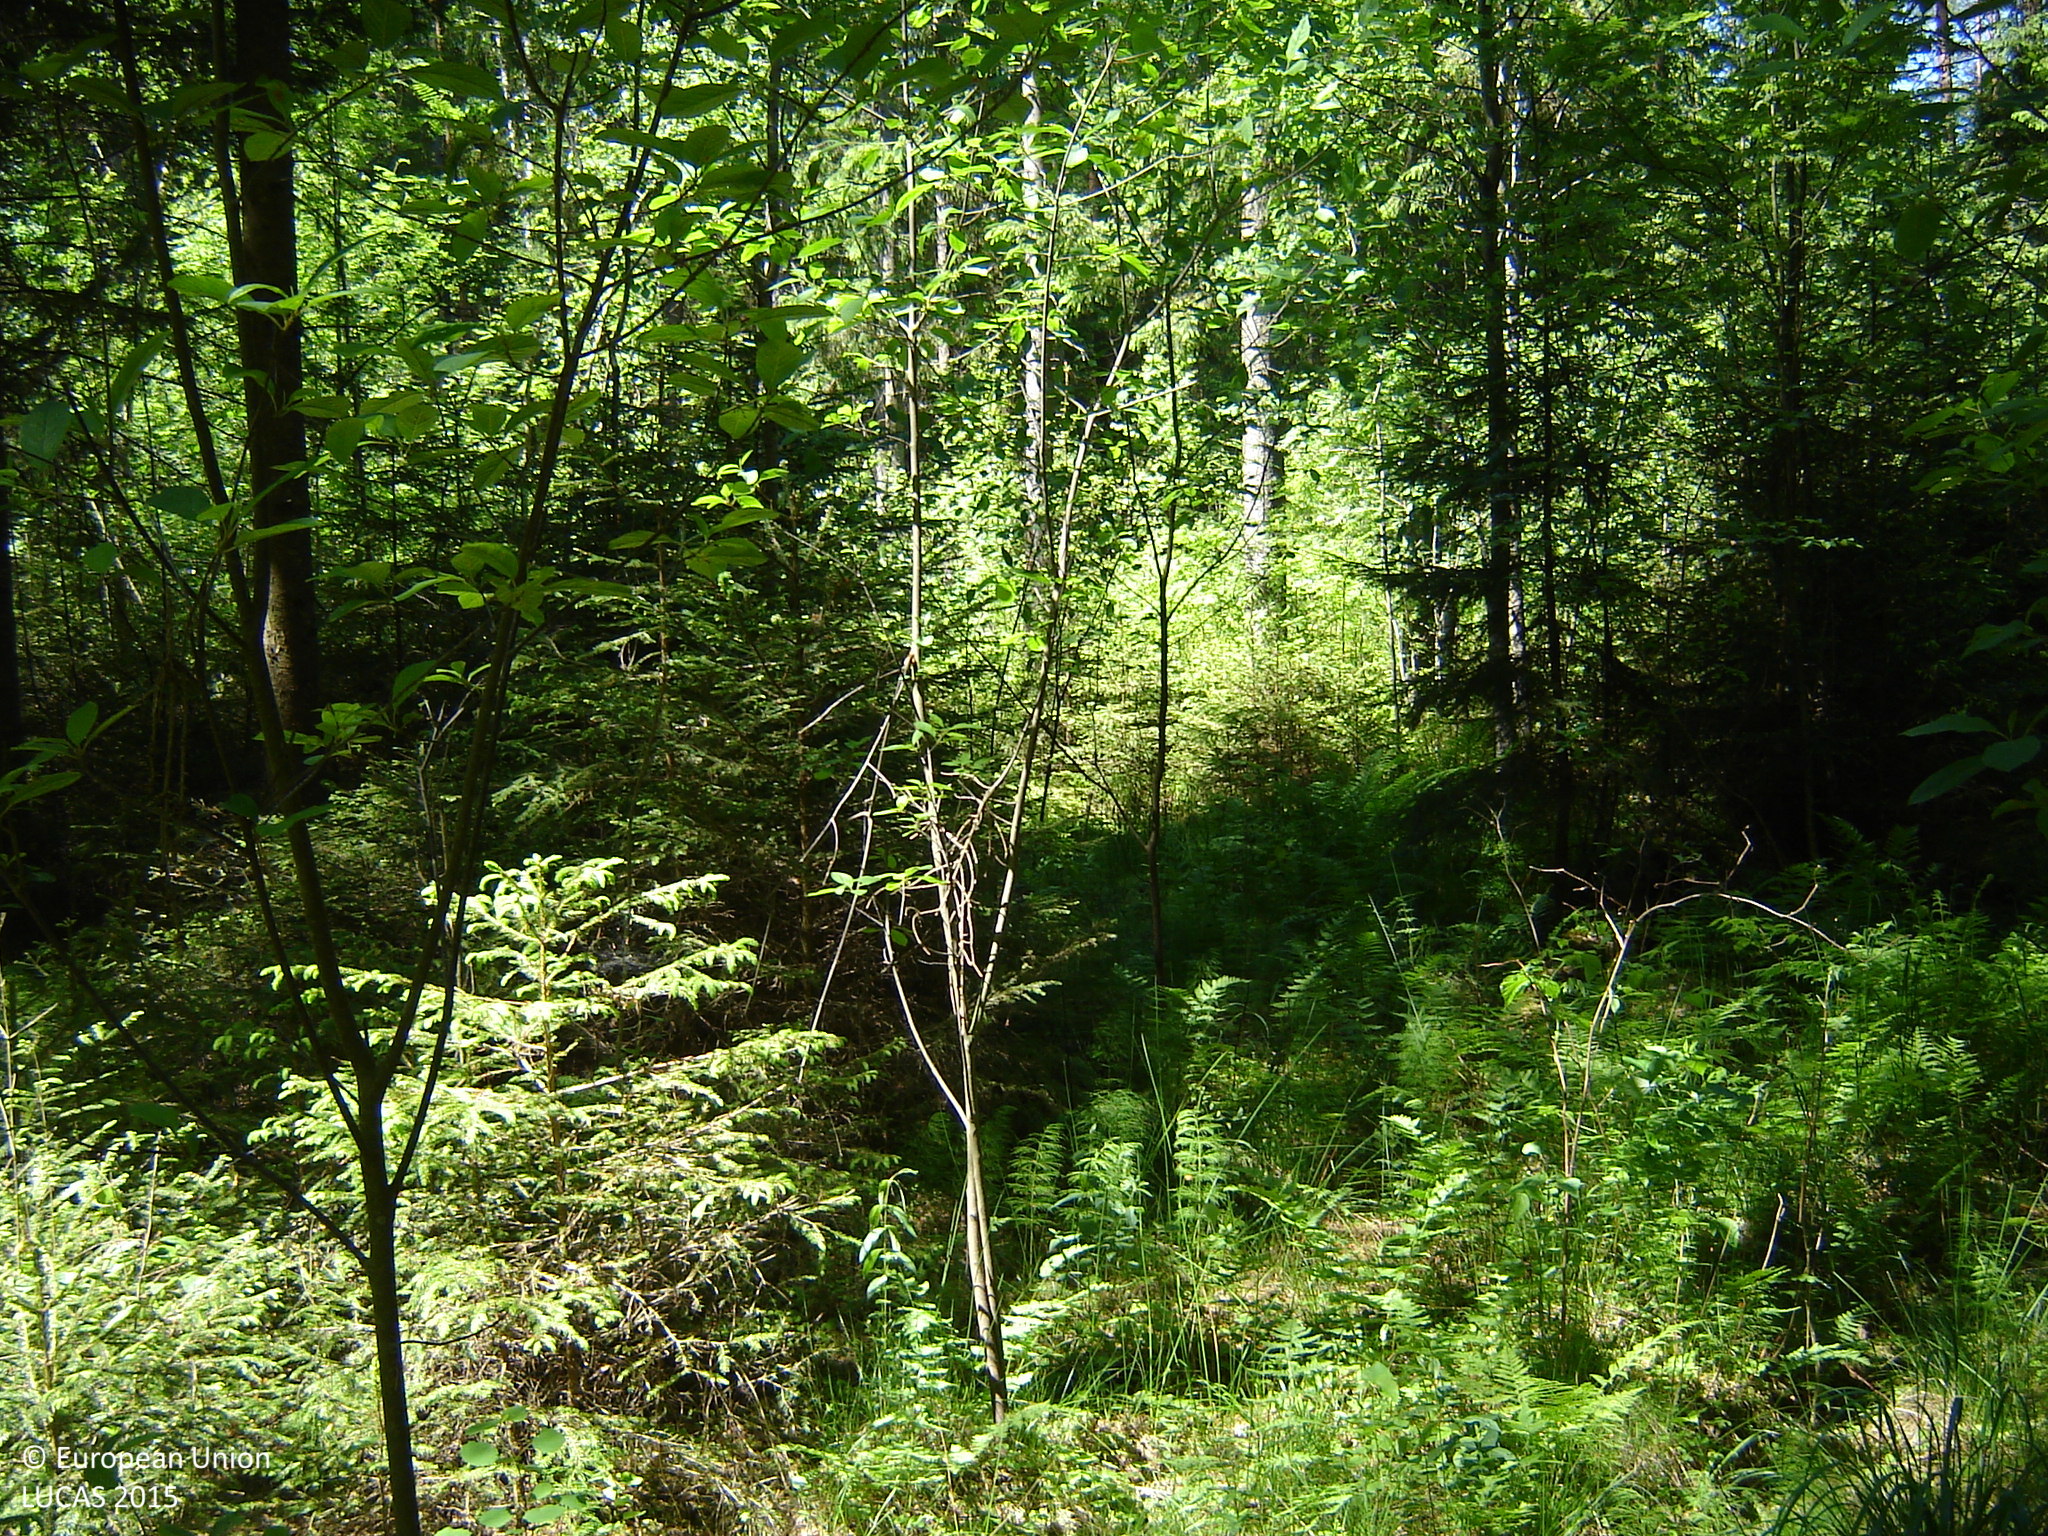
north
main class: Woodland
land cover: Spruce dominated coniferous woodland
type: hemiboreal forest and nemoral coniferous forest and mixed broadleaved-coniferous forest
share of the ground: > 75 %
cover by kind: coniferous forest trees 80 %, broadleaved forest trees 10 %, herbaceous plants 10 %
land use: Forestry
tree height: > 5 m
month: June
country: LT
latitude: 55.5932
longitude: 25.1422
